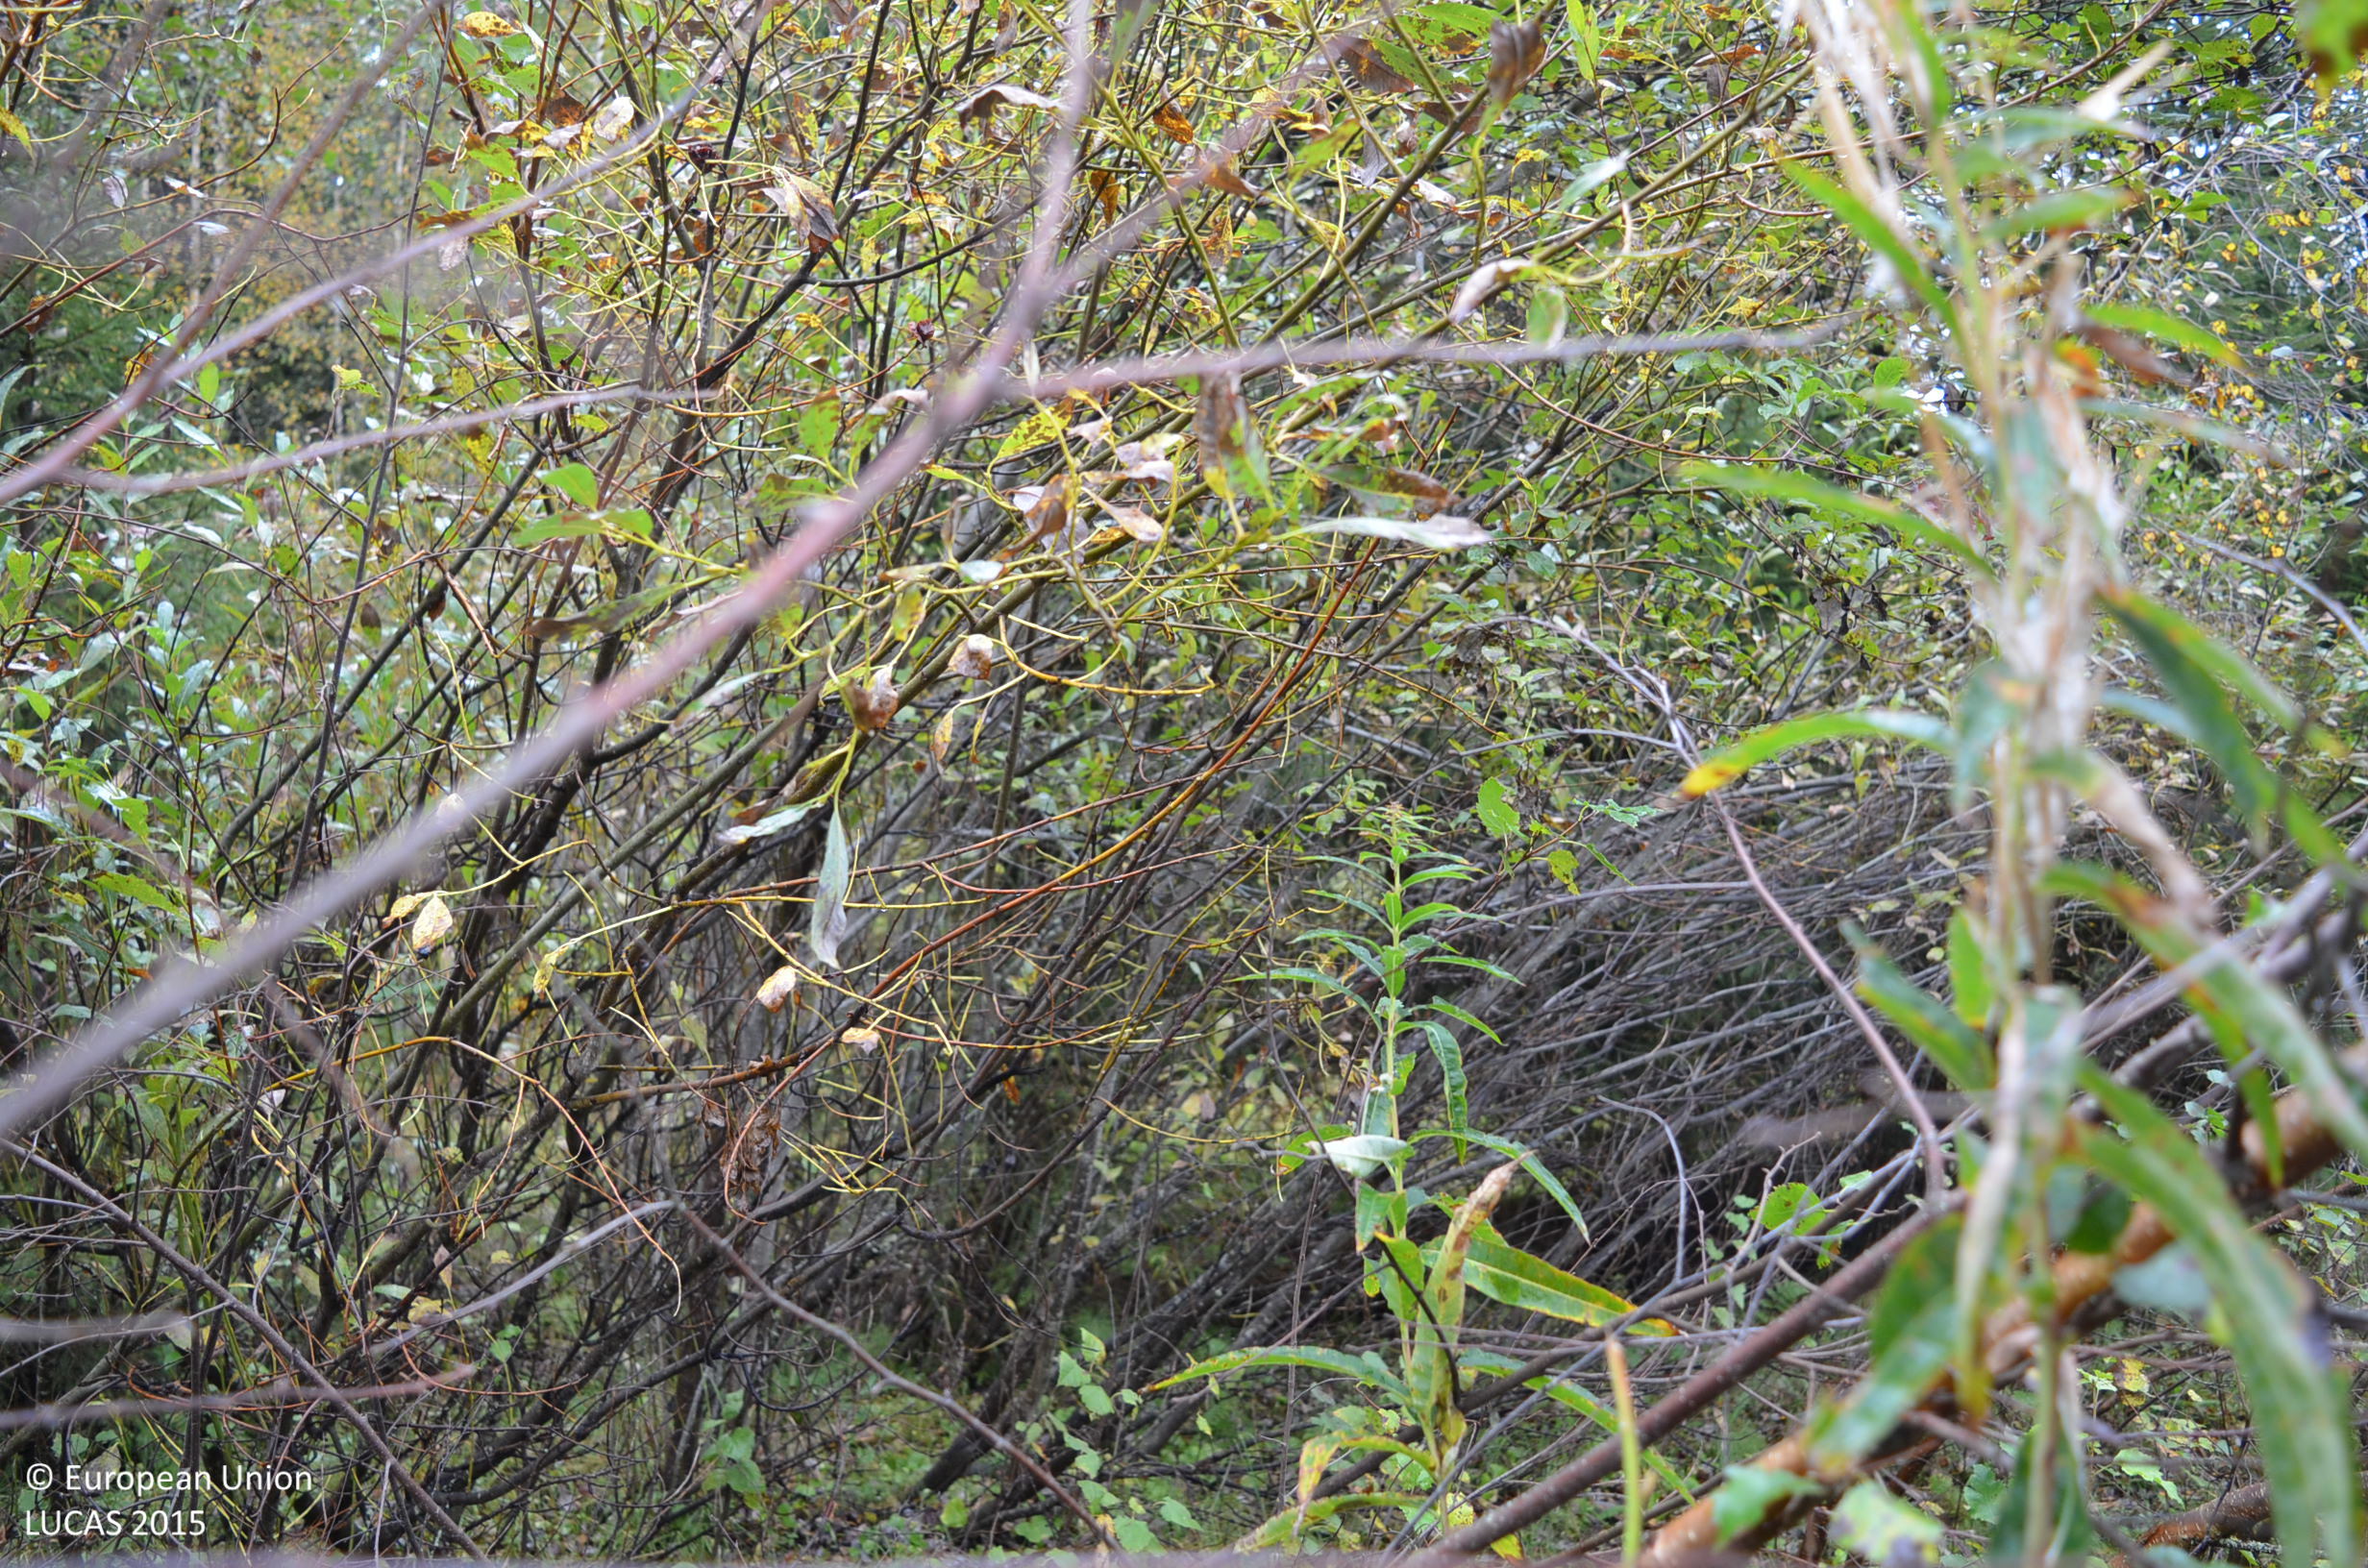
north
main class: Woodland
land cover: Broadleaved woodland
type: boreal forest
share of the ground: > 75 %
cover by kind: broadleaved forest trees 80 %, coniferous forest trees 15 %, shrubs 5 %
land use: Forestry
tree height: < 5 m
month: September
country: FI
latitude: 62.6881
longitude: 23.8083
